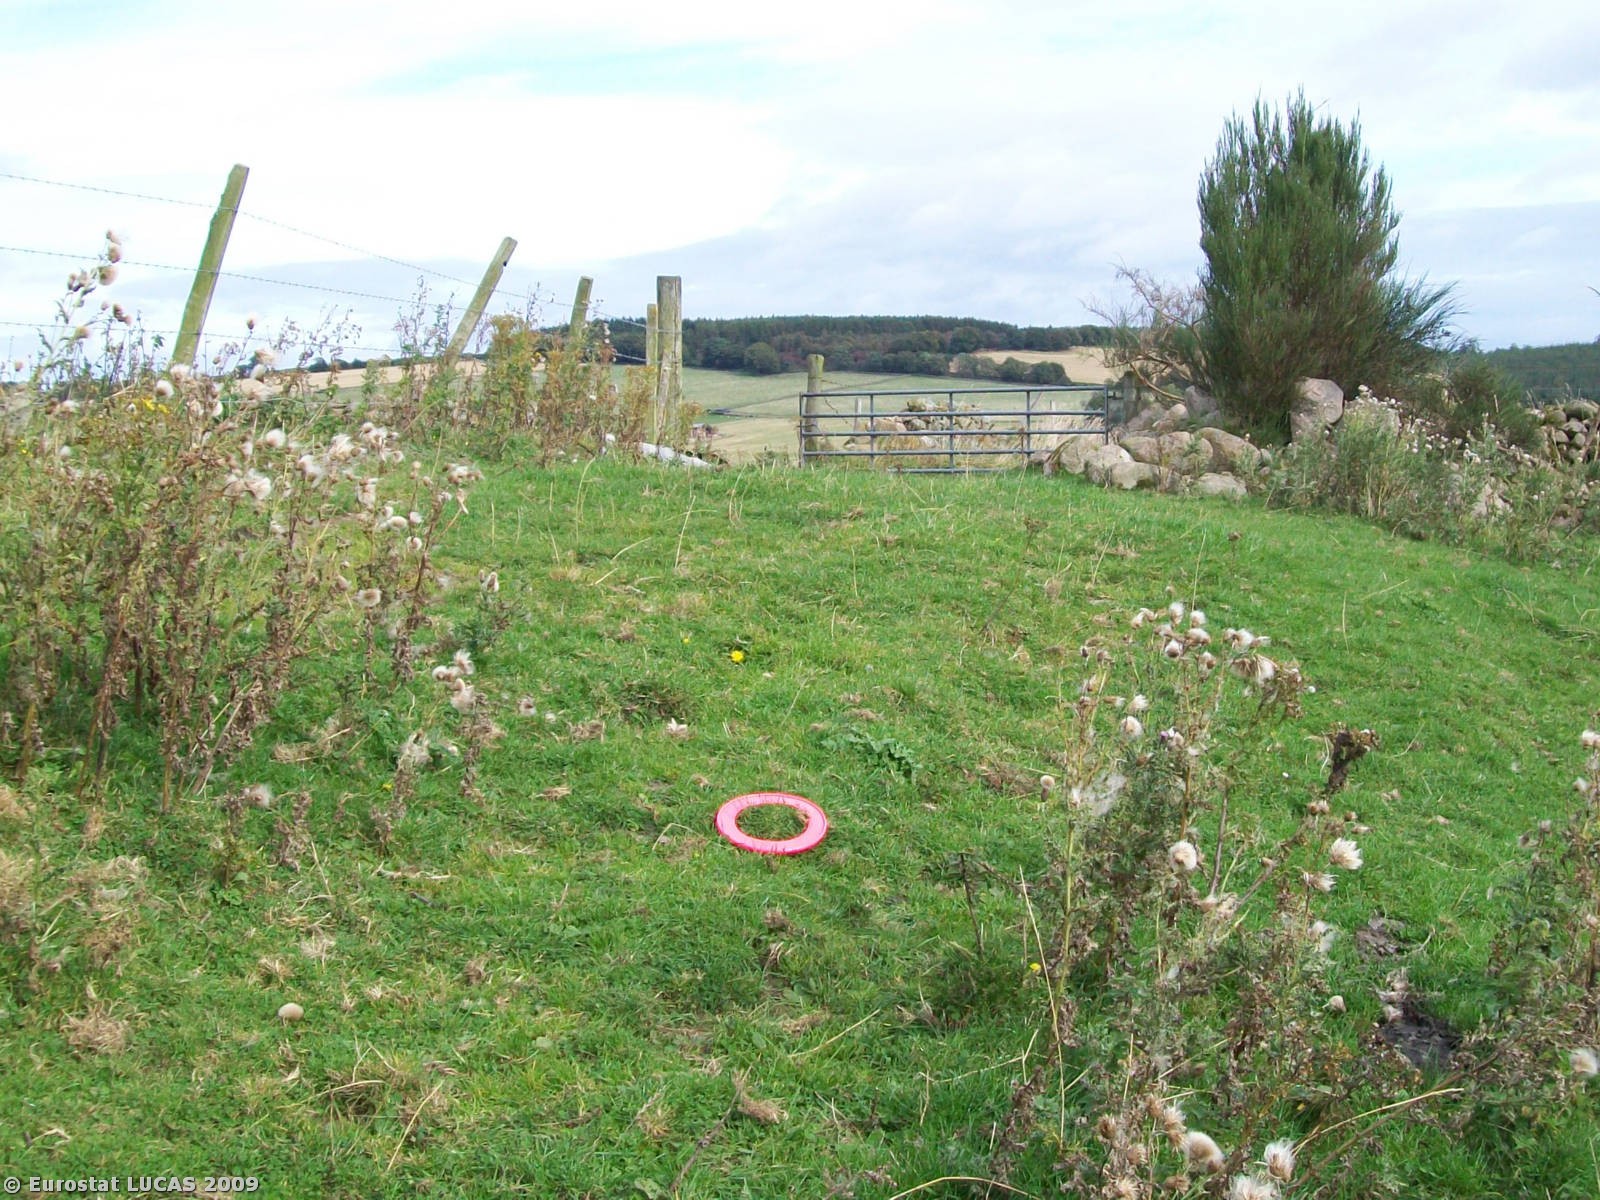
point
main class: Grassland
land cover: Grassland without tree/shrub cover
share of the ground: > 75 %
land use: Agriculture (excluding fallow land and kitchen gardens)
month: September
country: GB
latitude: 57.2708
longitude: -2.4744
